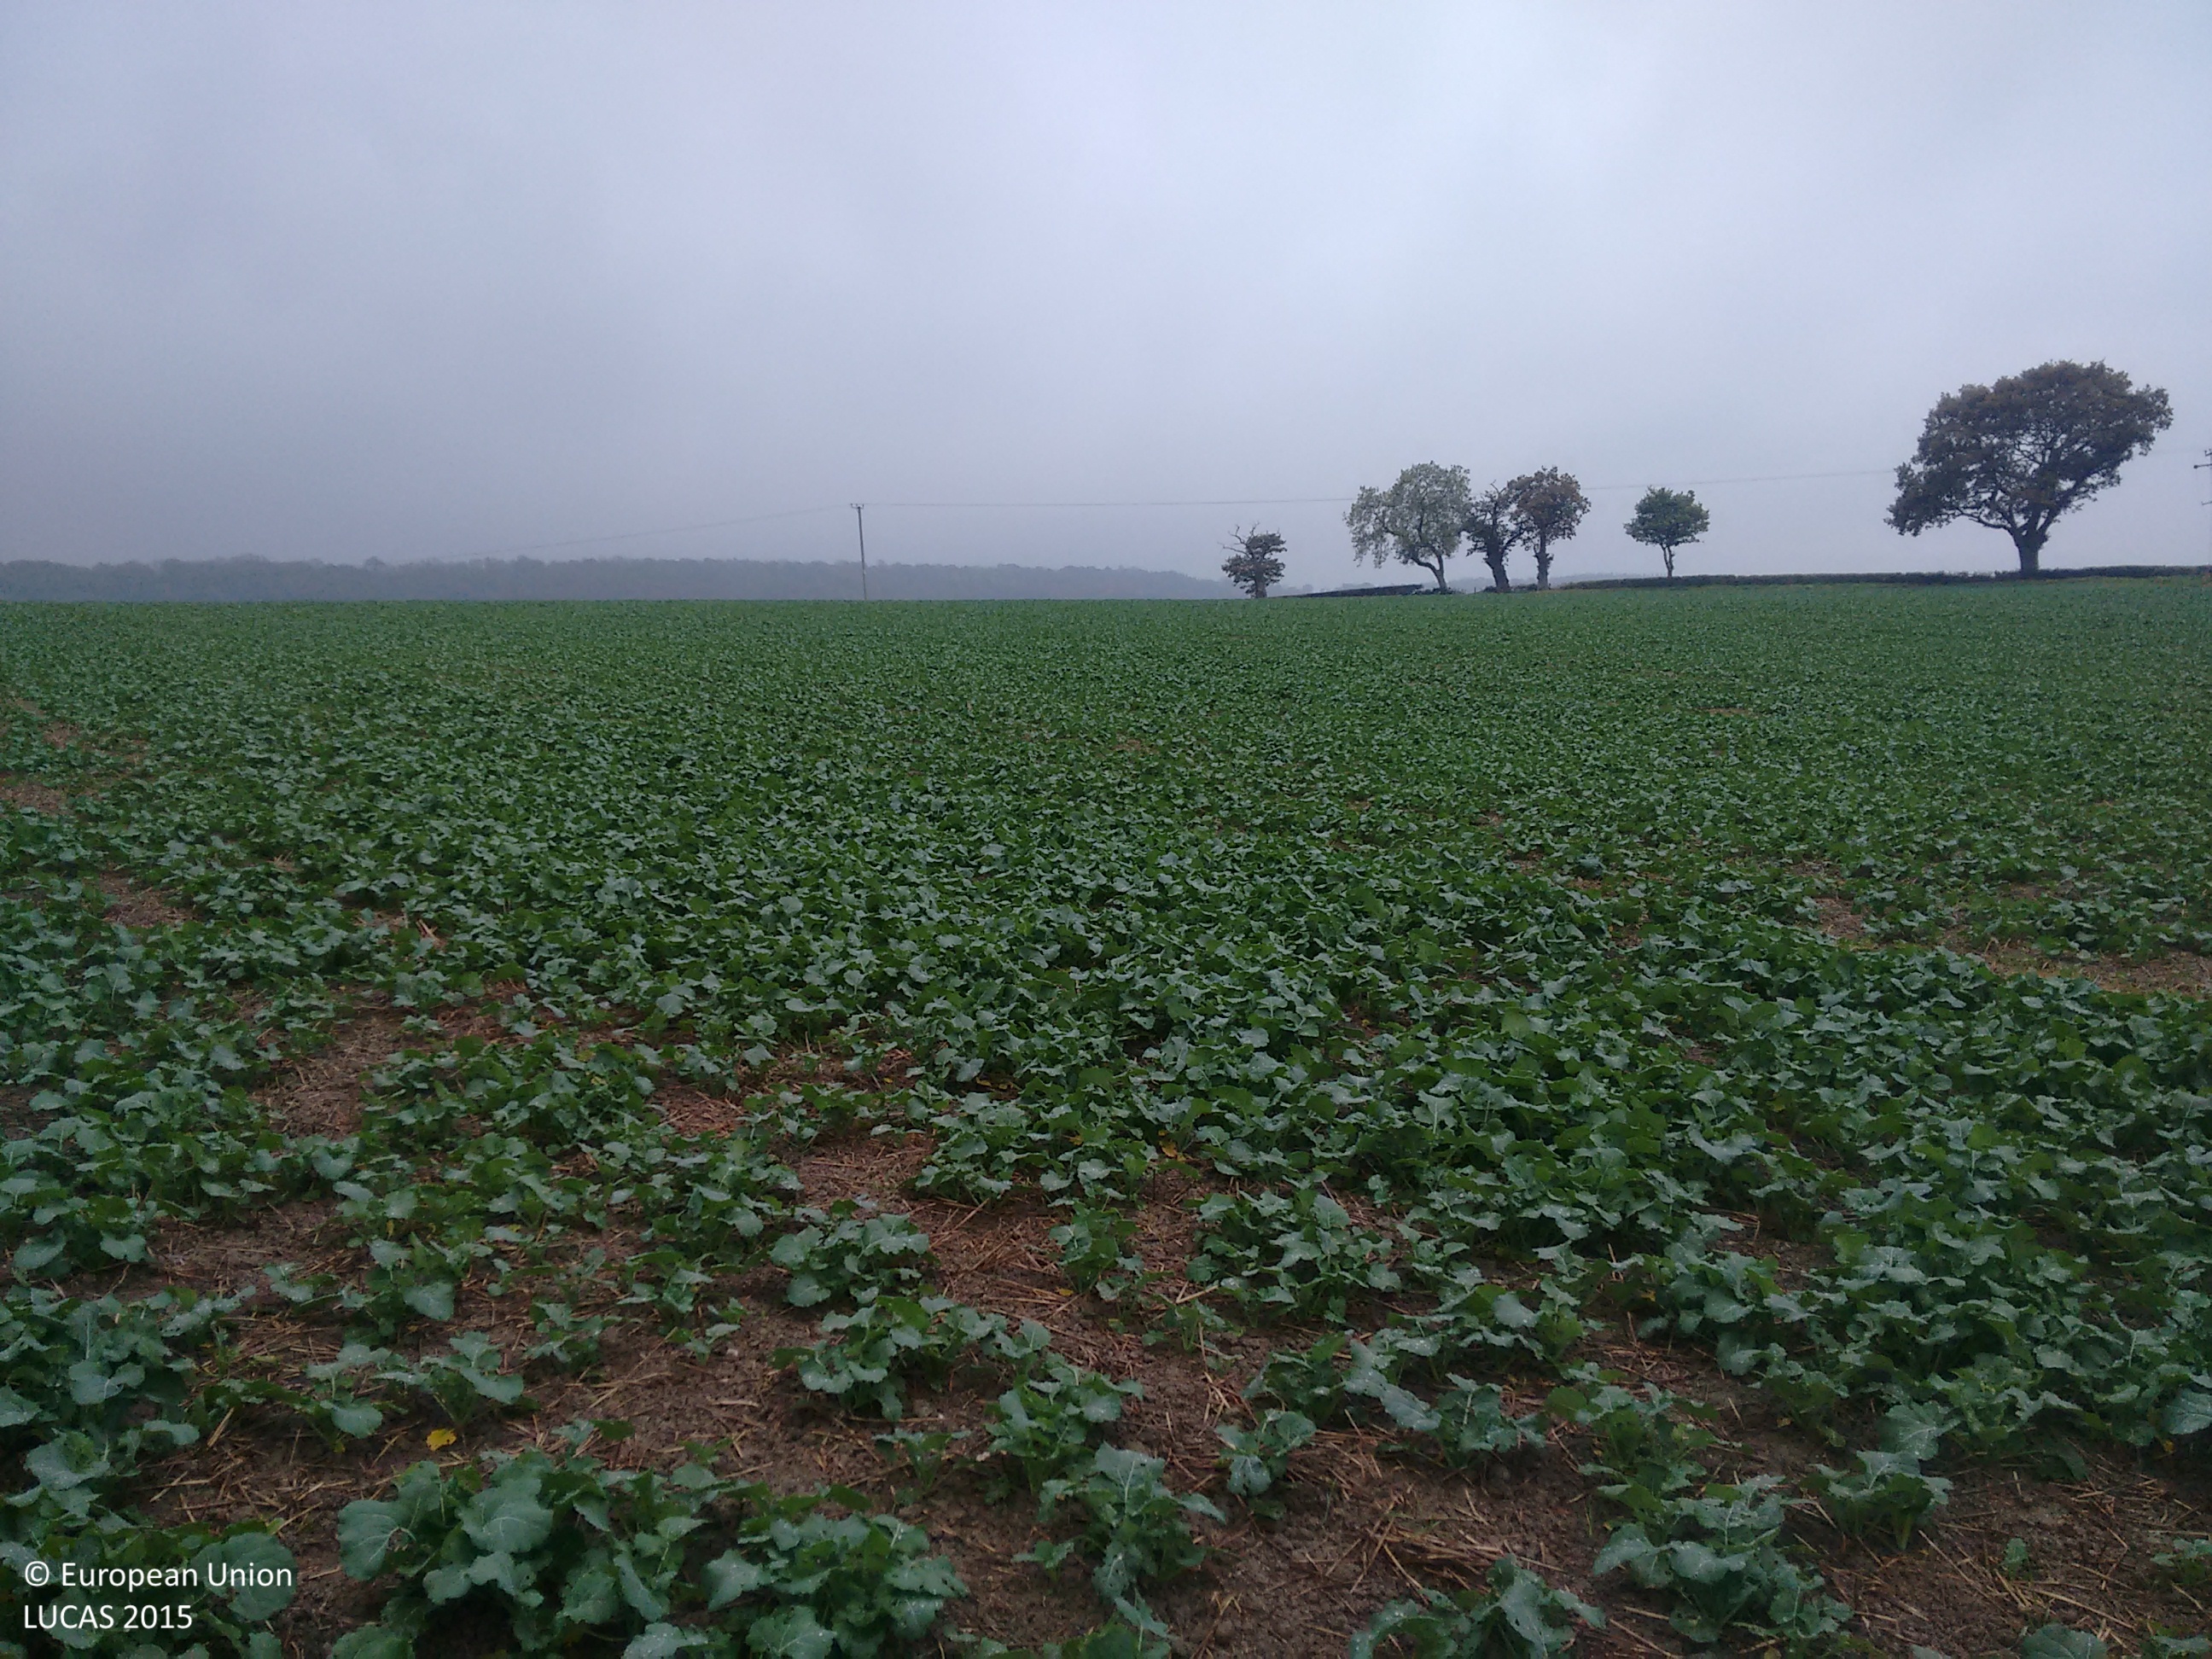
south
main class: Cropland
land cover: Rape and turnip rape
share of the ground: > 75 %
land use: Agriculture (excluding fallow land and kitchen gardens)
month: October
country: GB
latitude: 52.4814
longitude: -2.8083
